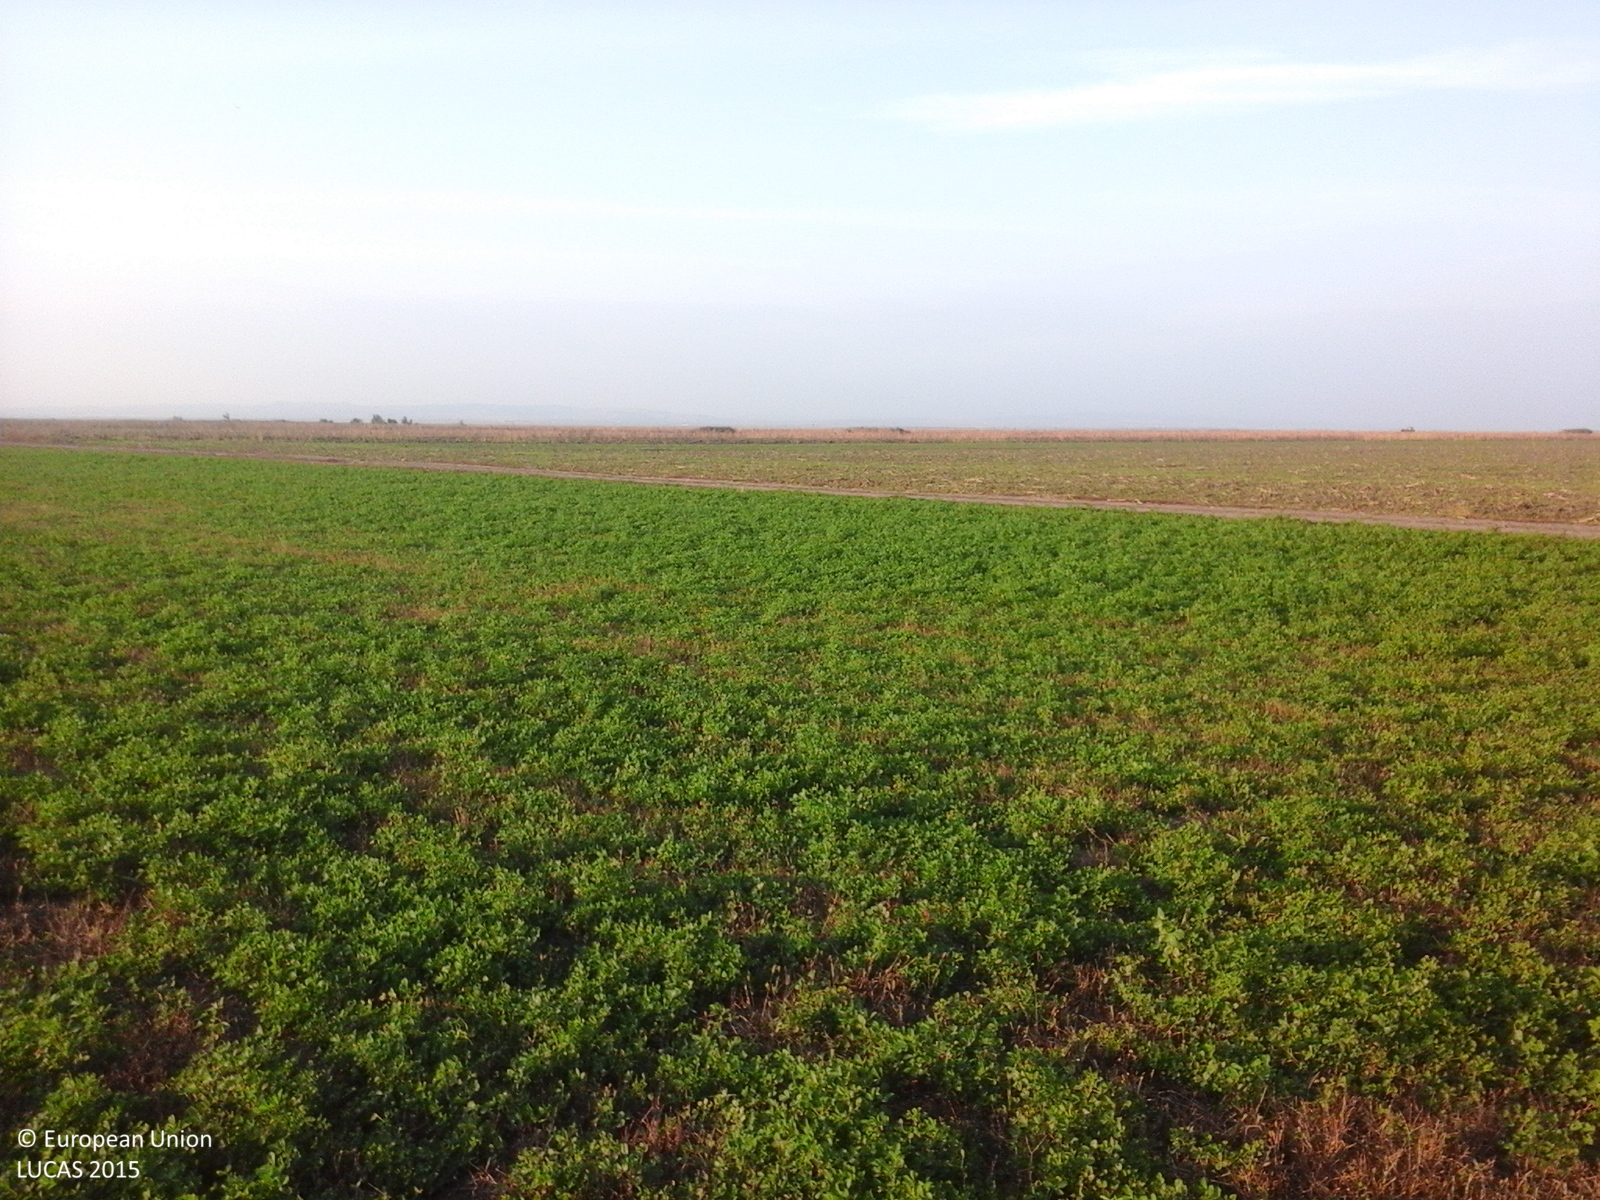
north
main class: Cropland
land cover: Lucerne
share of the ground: > 75 %
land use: Agriculture (excluding fallow land and kitchen gardens)
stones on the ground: < 10 %
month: October
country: RO
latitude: 45.1318
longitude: 26.9563
